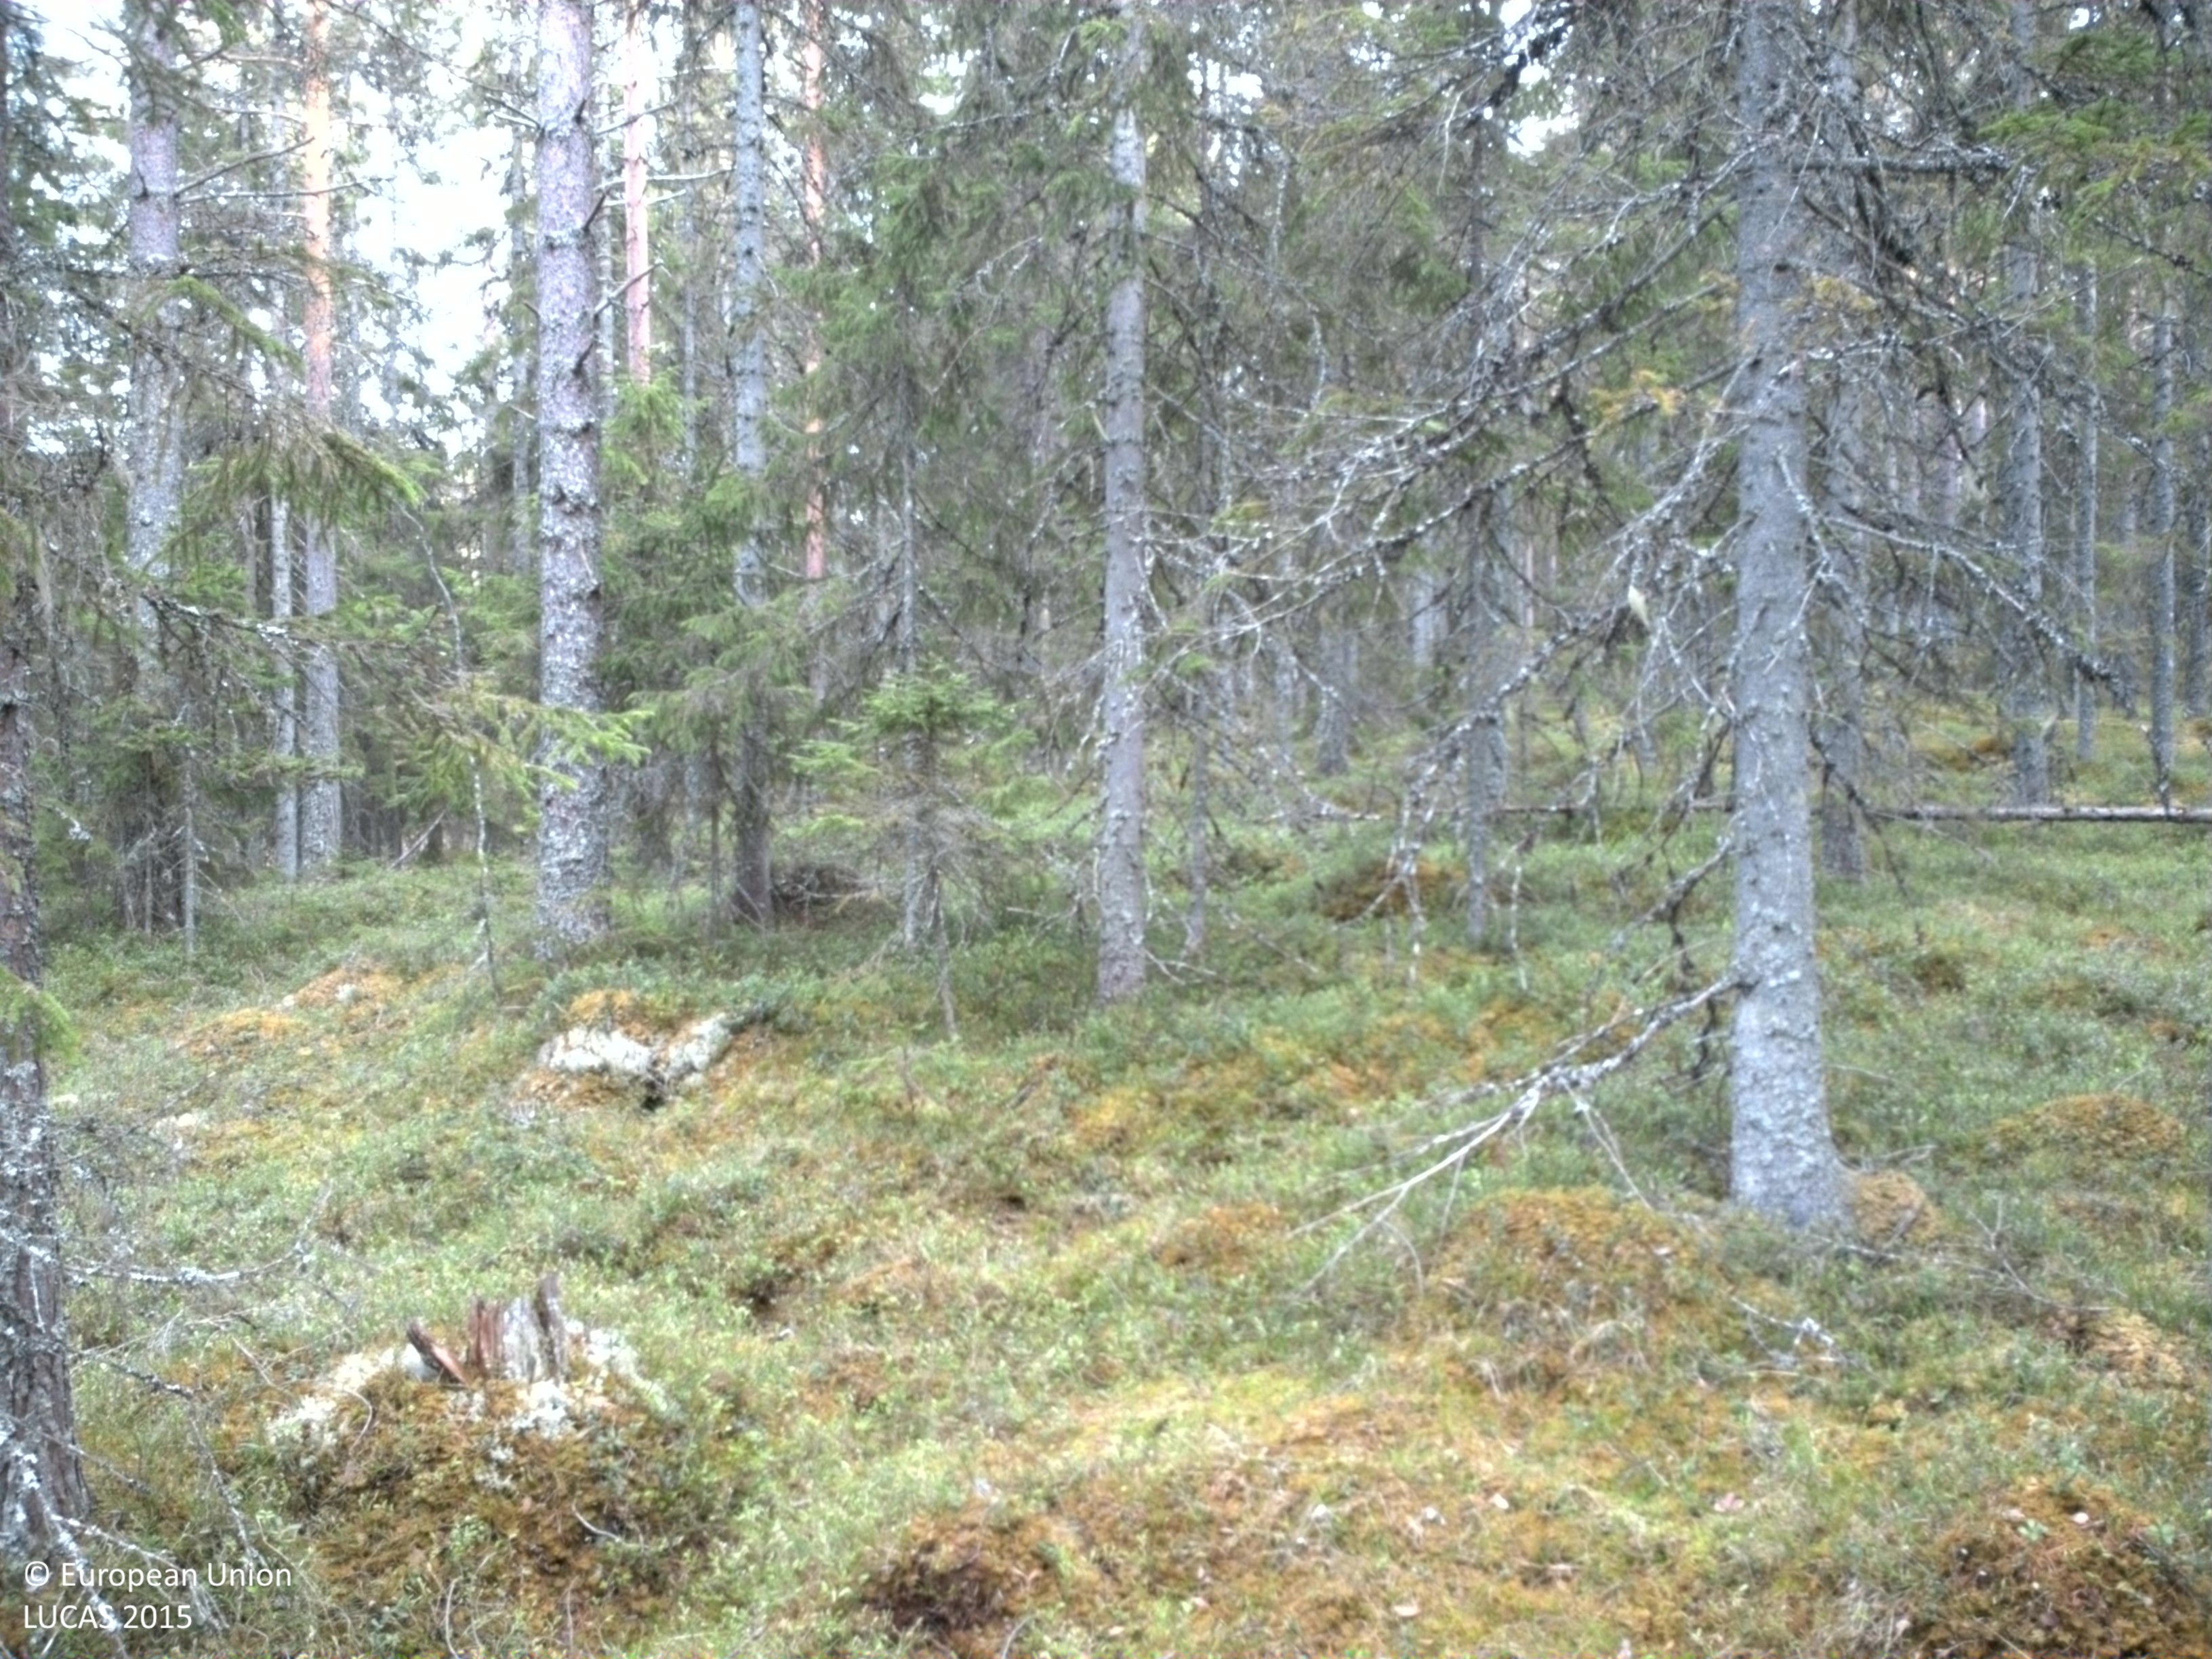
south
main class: Woodland
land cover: Spruce dominated coniferous woodland
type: boreal forest
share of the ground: > 75 %
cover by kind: coniferous forest trees 75 %, herbaceous plants 15 %, lichens and mosses 10 %
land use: Forestry
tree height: > 5 m
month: May
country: SE
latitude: 61.1214
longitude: 14.9788
